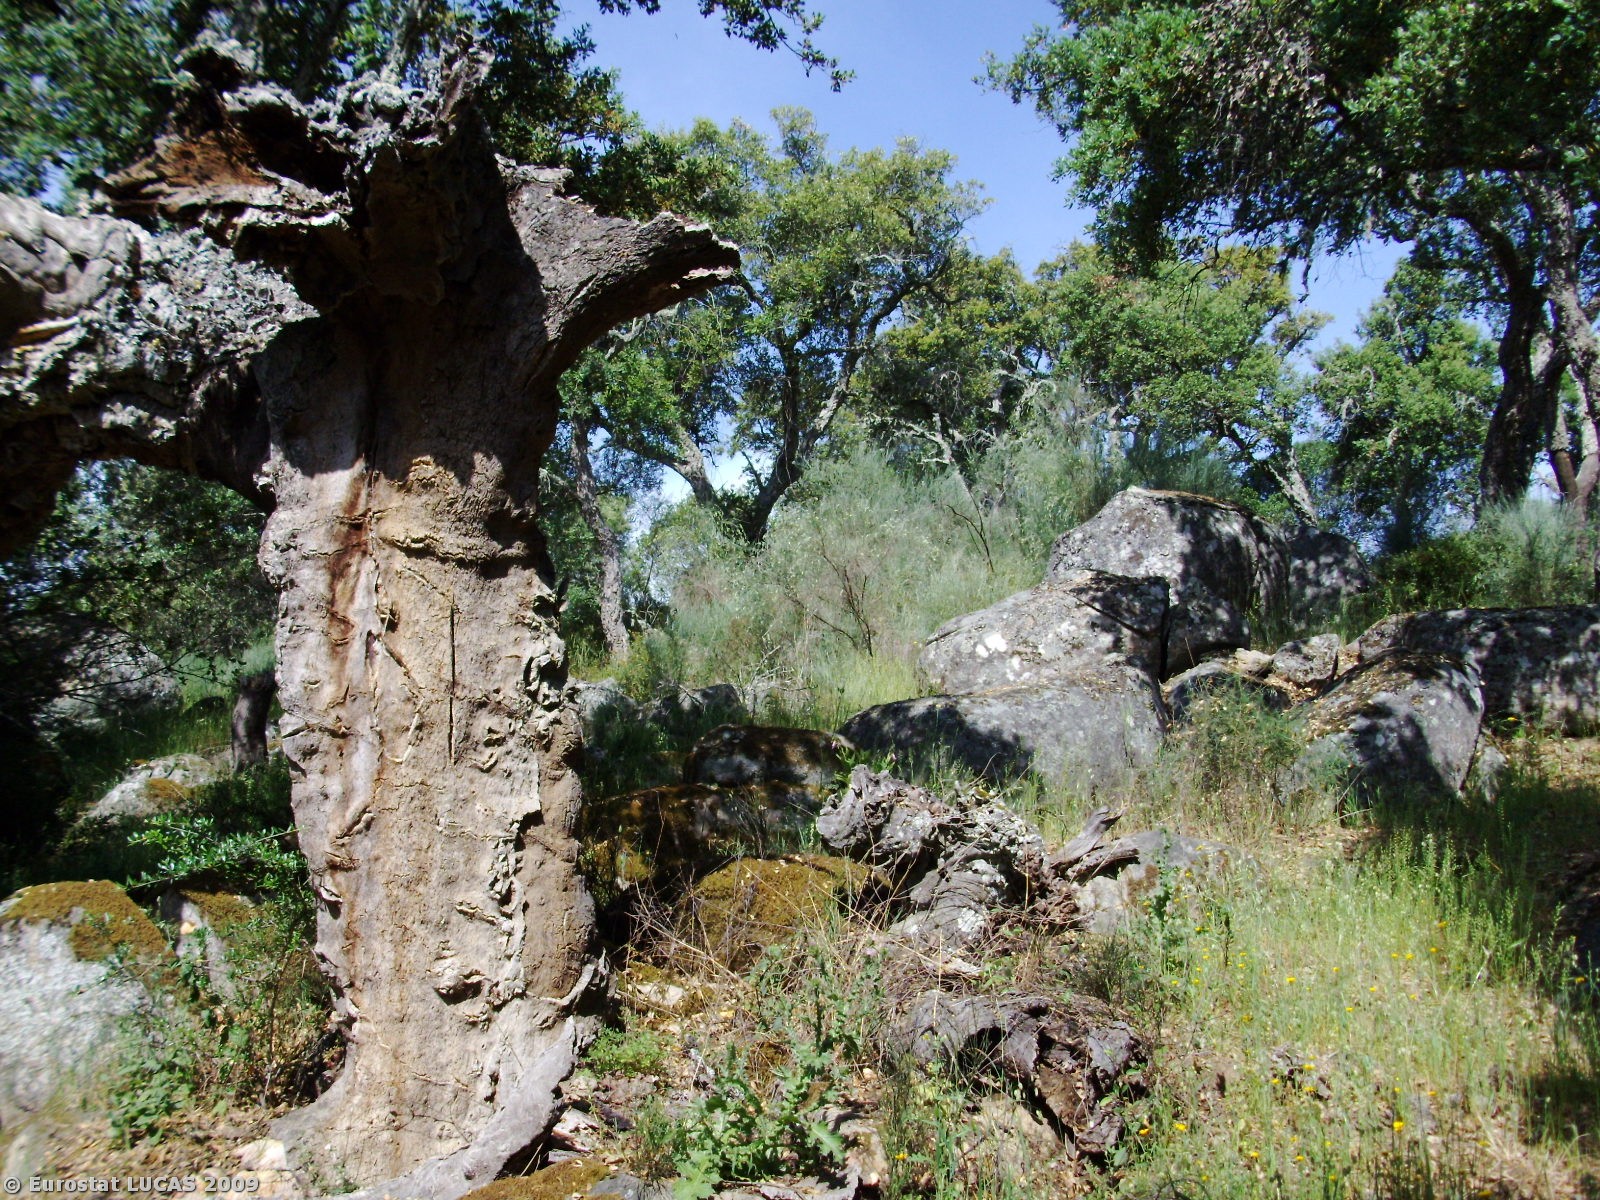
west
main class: Woodland
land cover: Broadleaved woodland
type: broadleaved evergreen forest
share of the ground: 50 - 75 %
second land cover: Shrubland with sparse tree cover
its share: 25 - 50 %
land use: Forestry
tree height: > 5 m
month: May
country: PT
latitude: 39.2778
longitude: -7.4650
